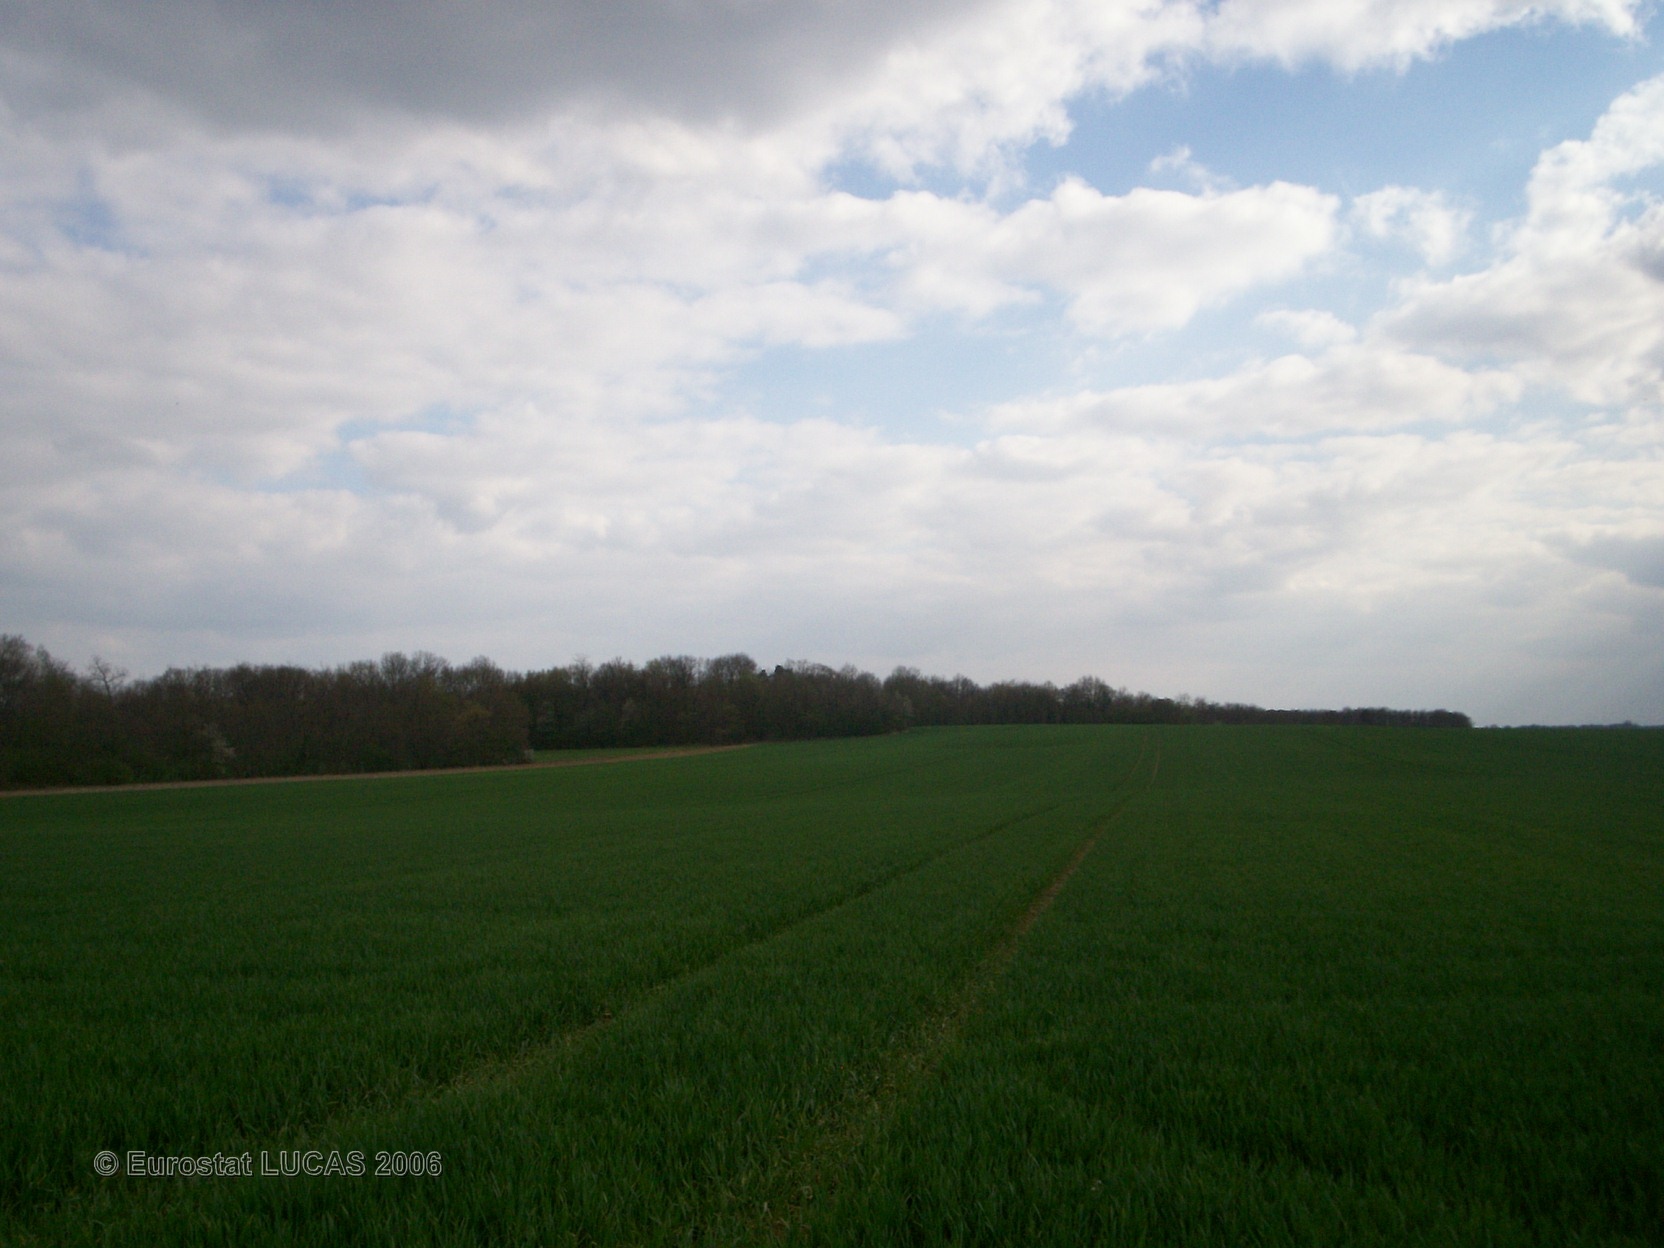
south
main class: Cropland
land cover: Common wheat
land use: Agriculture (excluding fallow land and kitchen gardens)
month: April
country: FR
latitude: 48.3008
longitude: 2.8873
